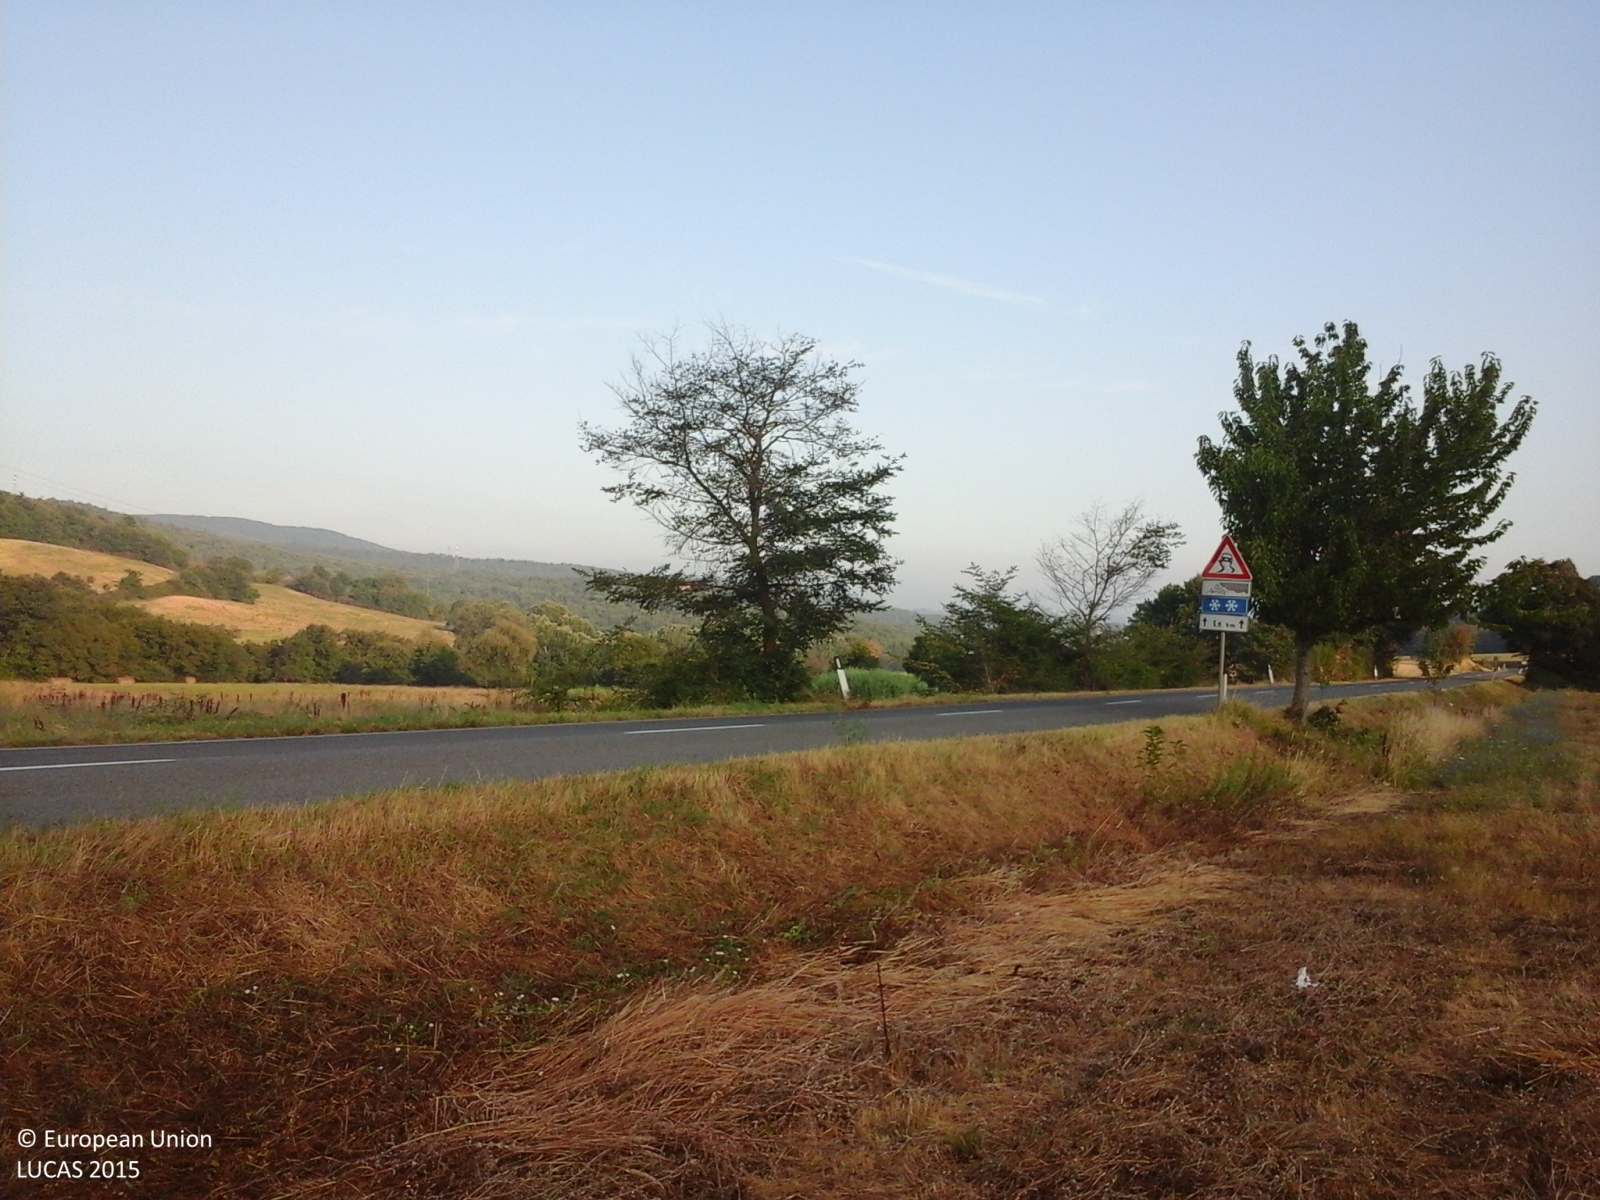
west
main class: Grassland
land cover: Grassland without tree/shrub cover
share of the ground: > 75 %
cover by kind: herbaceous plants 100 %
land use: Agriculture (excluding fallow land and kitchen gardens)
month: July
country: IT
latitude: 43.2796
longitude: 11.1427
